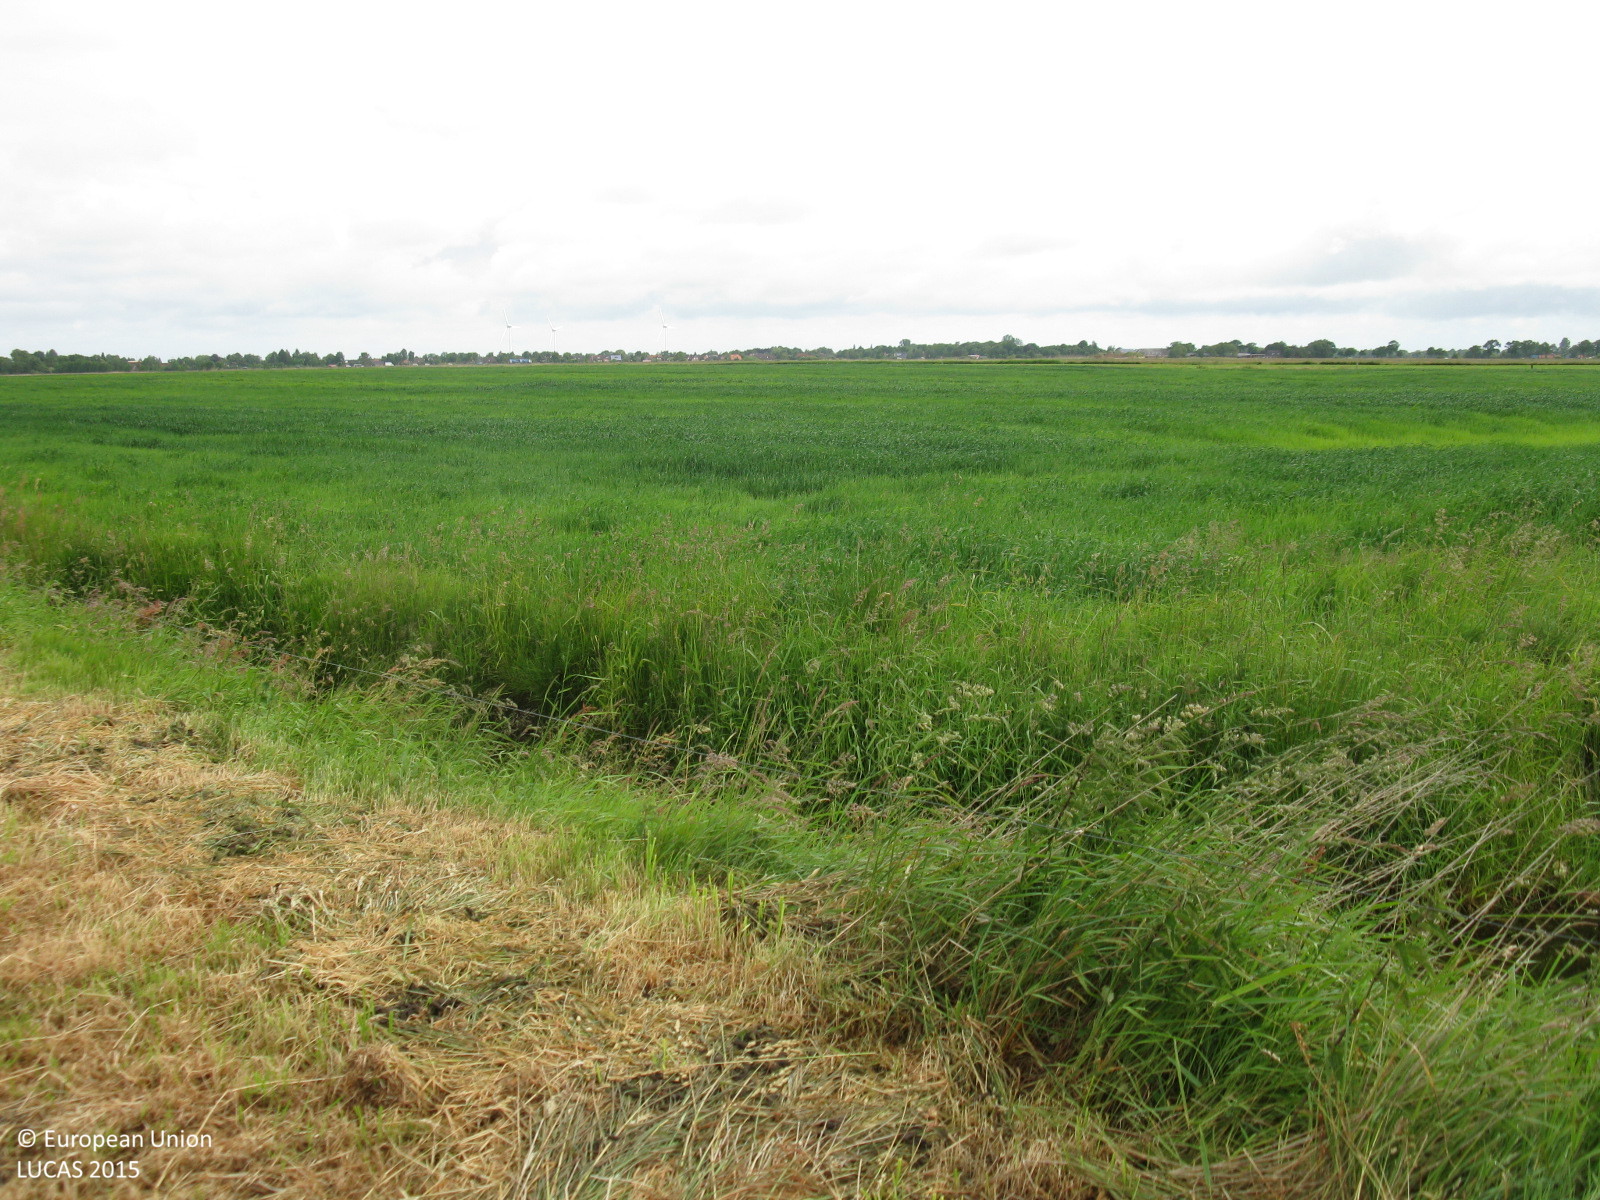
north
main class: Grassland
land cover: Grassland without tree/shrub cover
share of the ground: > 75 %
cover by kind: herbaceous plants 100 %
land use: Agriculture (excluding fallow land and kitchen gardens)
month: June
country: DE
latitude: 53.4626
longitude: 7.3346
